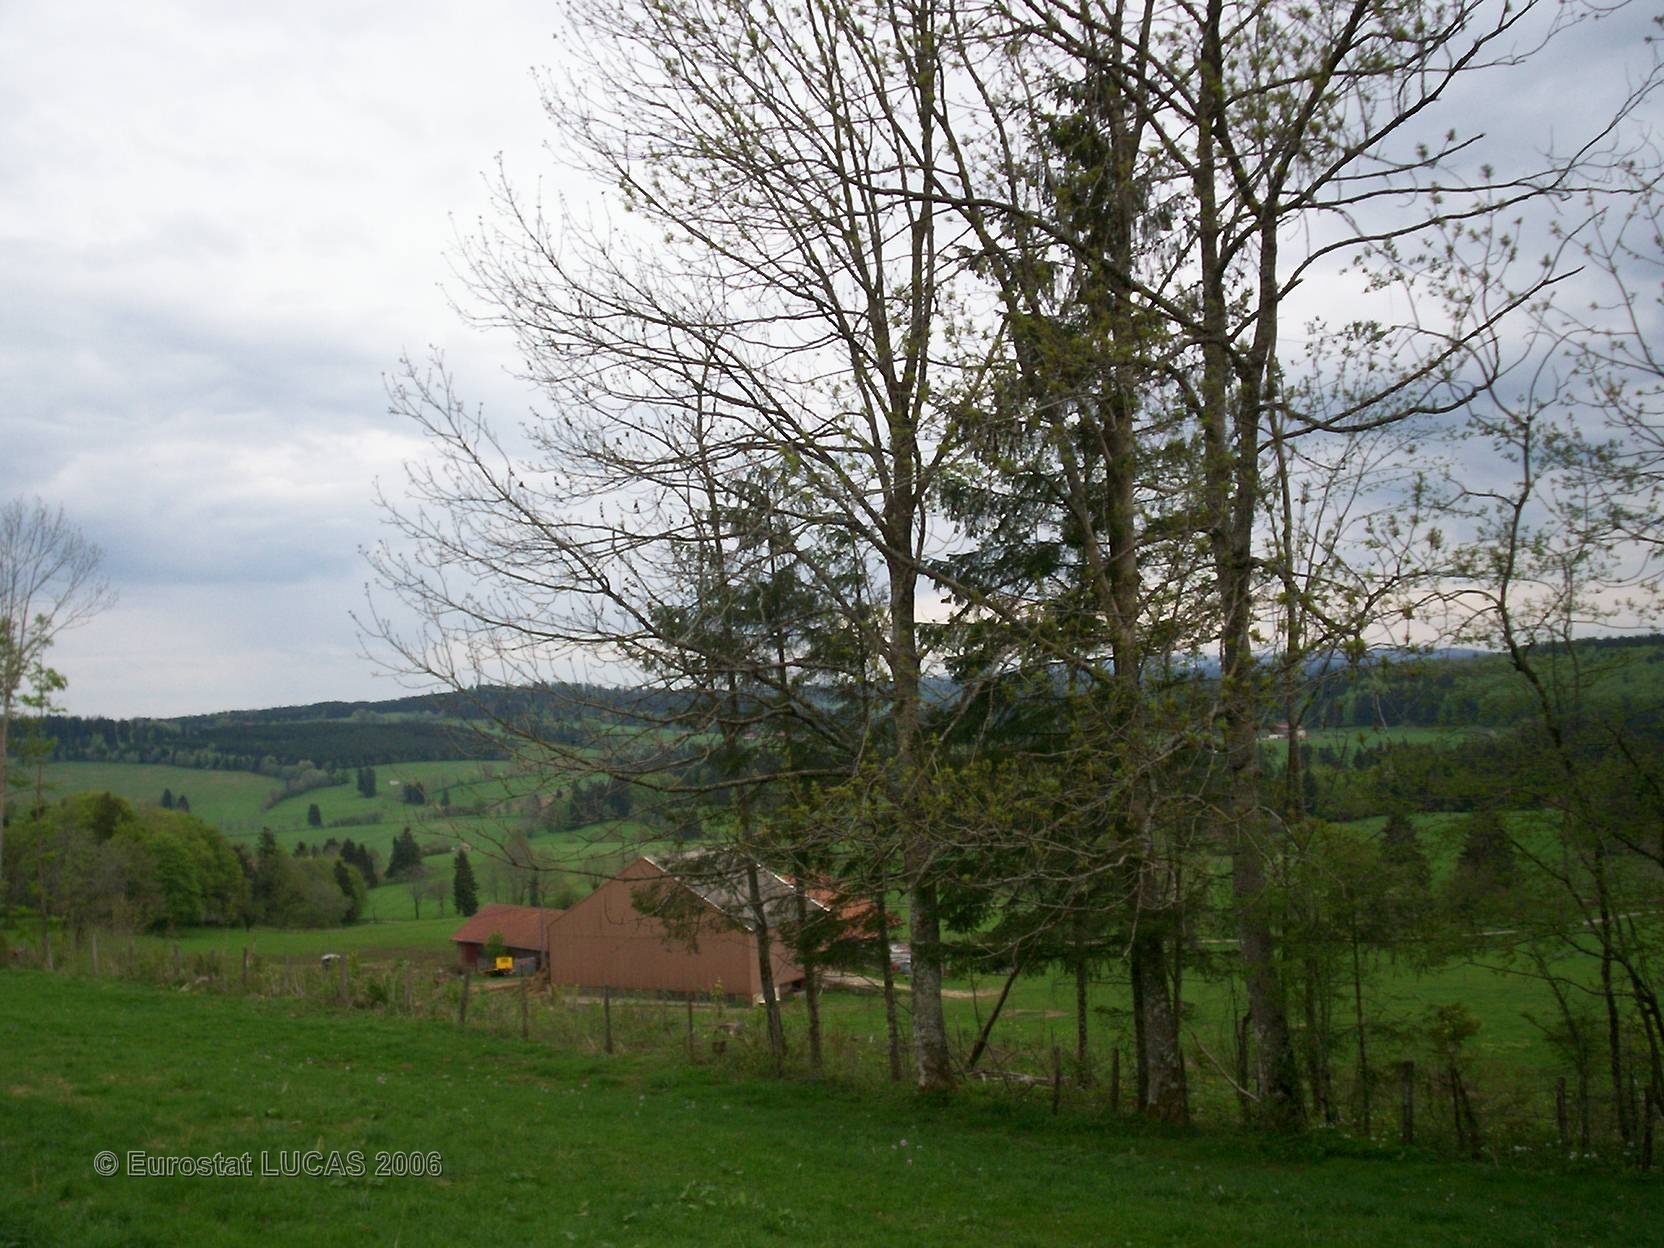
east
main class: Grassland
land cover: Grassland without tree/shrub cover
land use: Agriculture (excluding fallow land and kitchen gardens)
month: May
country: FR
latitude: 47.2238
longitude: 6.8457
